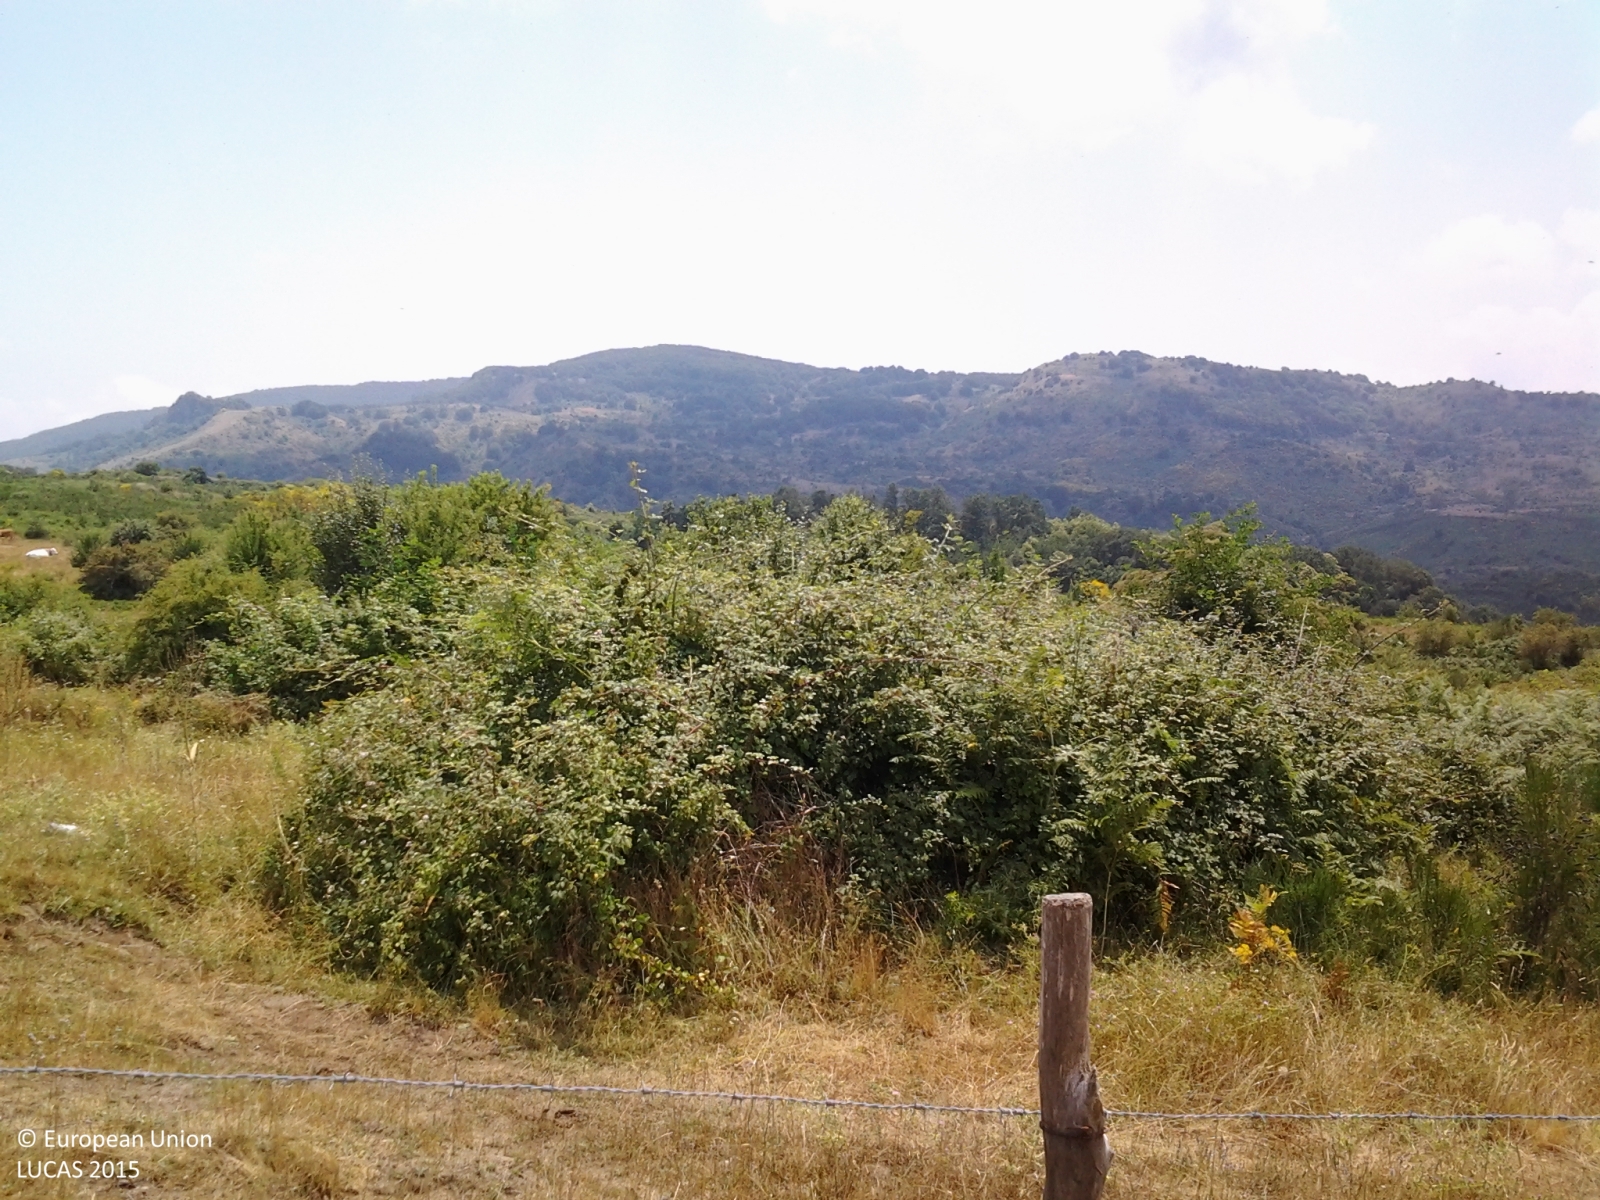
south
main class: Shrubland
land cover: Shrubland with sparse tree cover
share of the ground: > 75 %
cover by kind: shrubs 80 %, unconsolidated bare surface 10 %, broadleaved forest trees 5 %, herbaceous plants 5 %
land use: Agriculture (excluding fallow land and kitchen gardens)
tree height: < 5 m
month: July
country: IT
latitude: 37.9668
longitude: 14.8958
